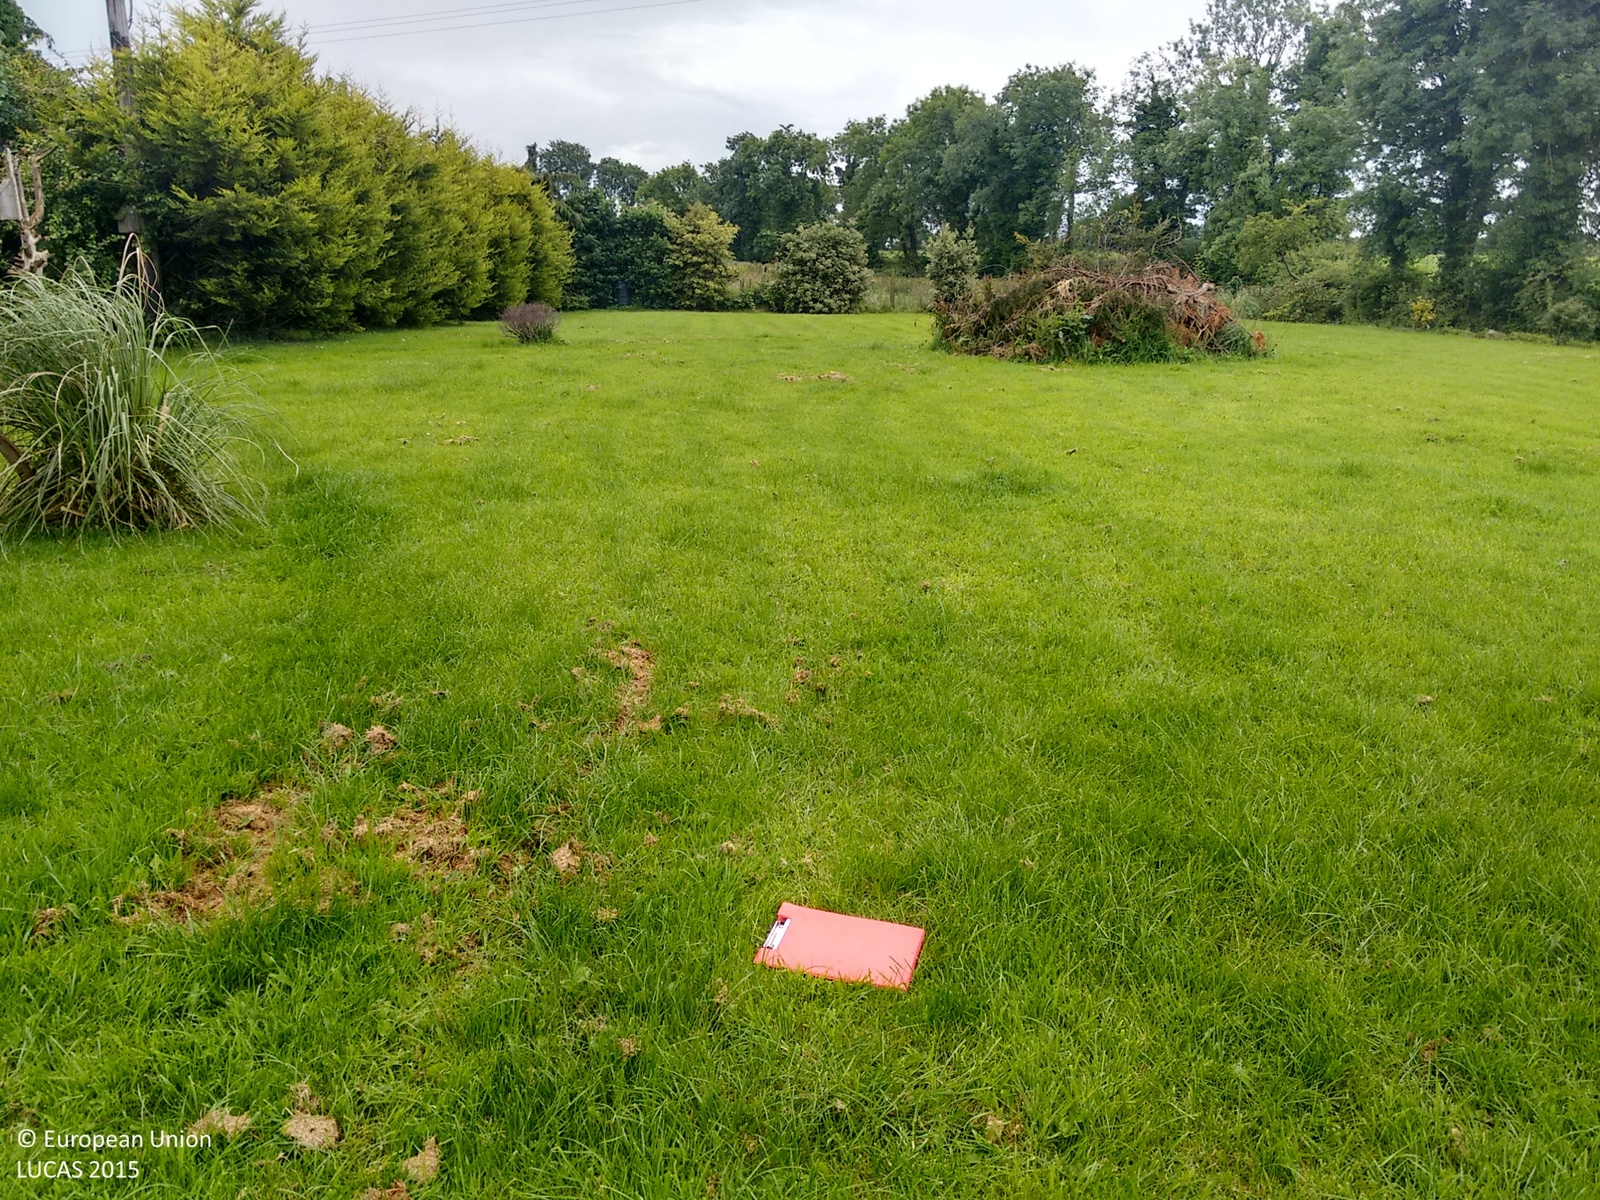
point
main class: Grassland
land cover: Grassland without tree/shrub cover
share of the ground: > 75 %
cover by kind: herbaceous plants 95 %, shrubs 5 %
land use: Residential
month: July
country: IE
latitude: 53.7324
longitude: -7.7656
